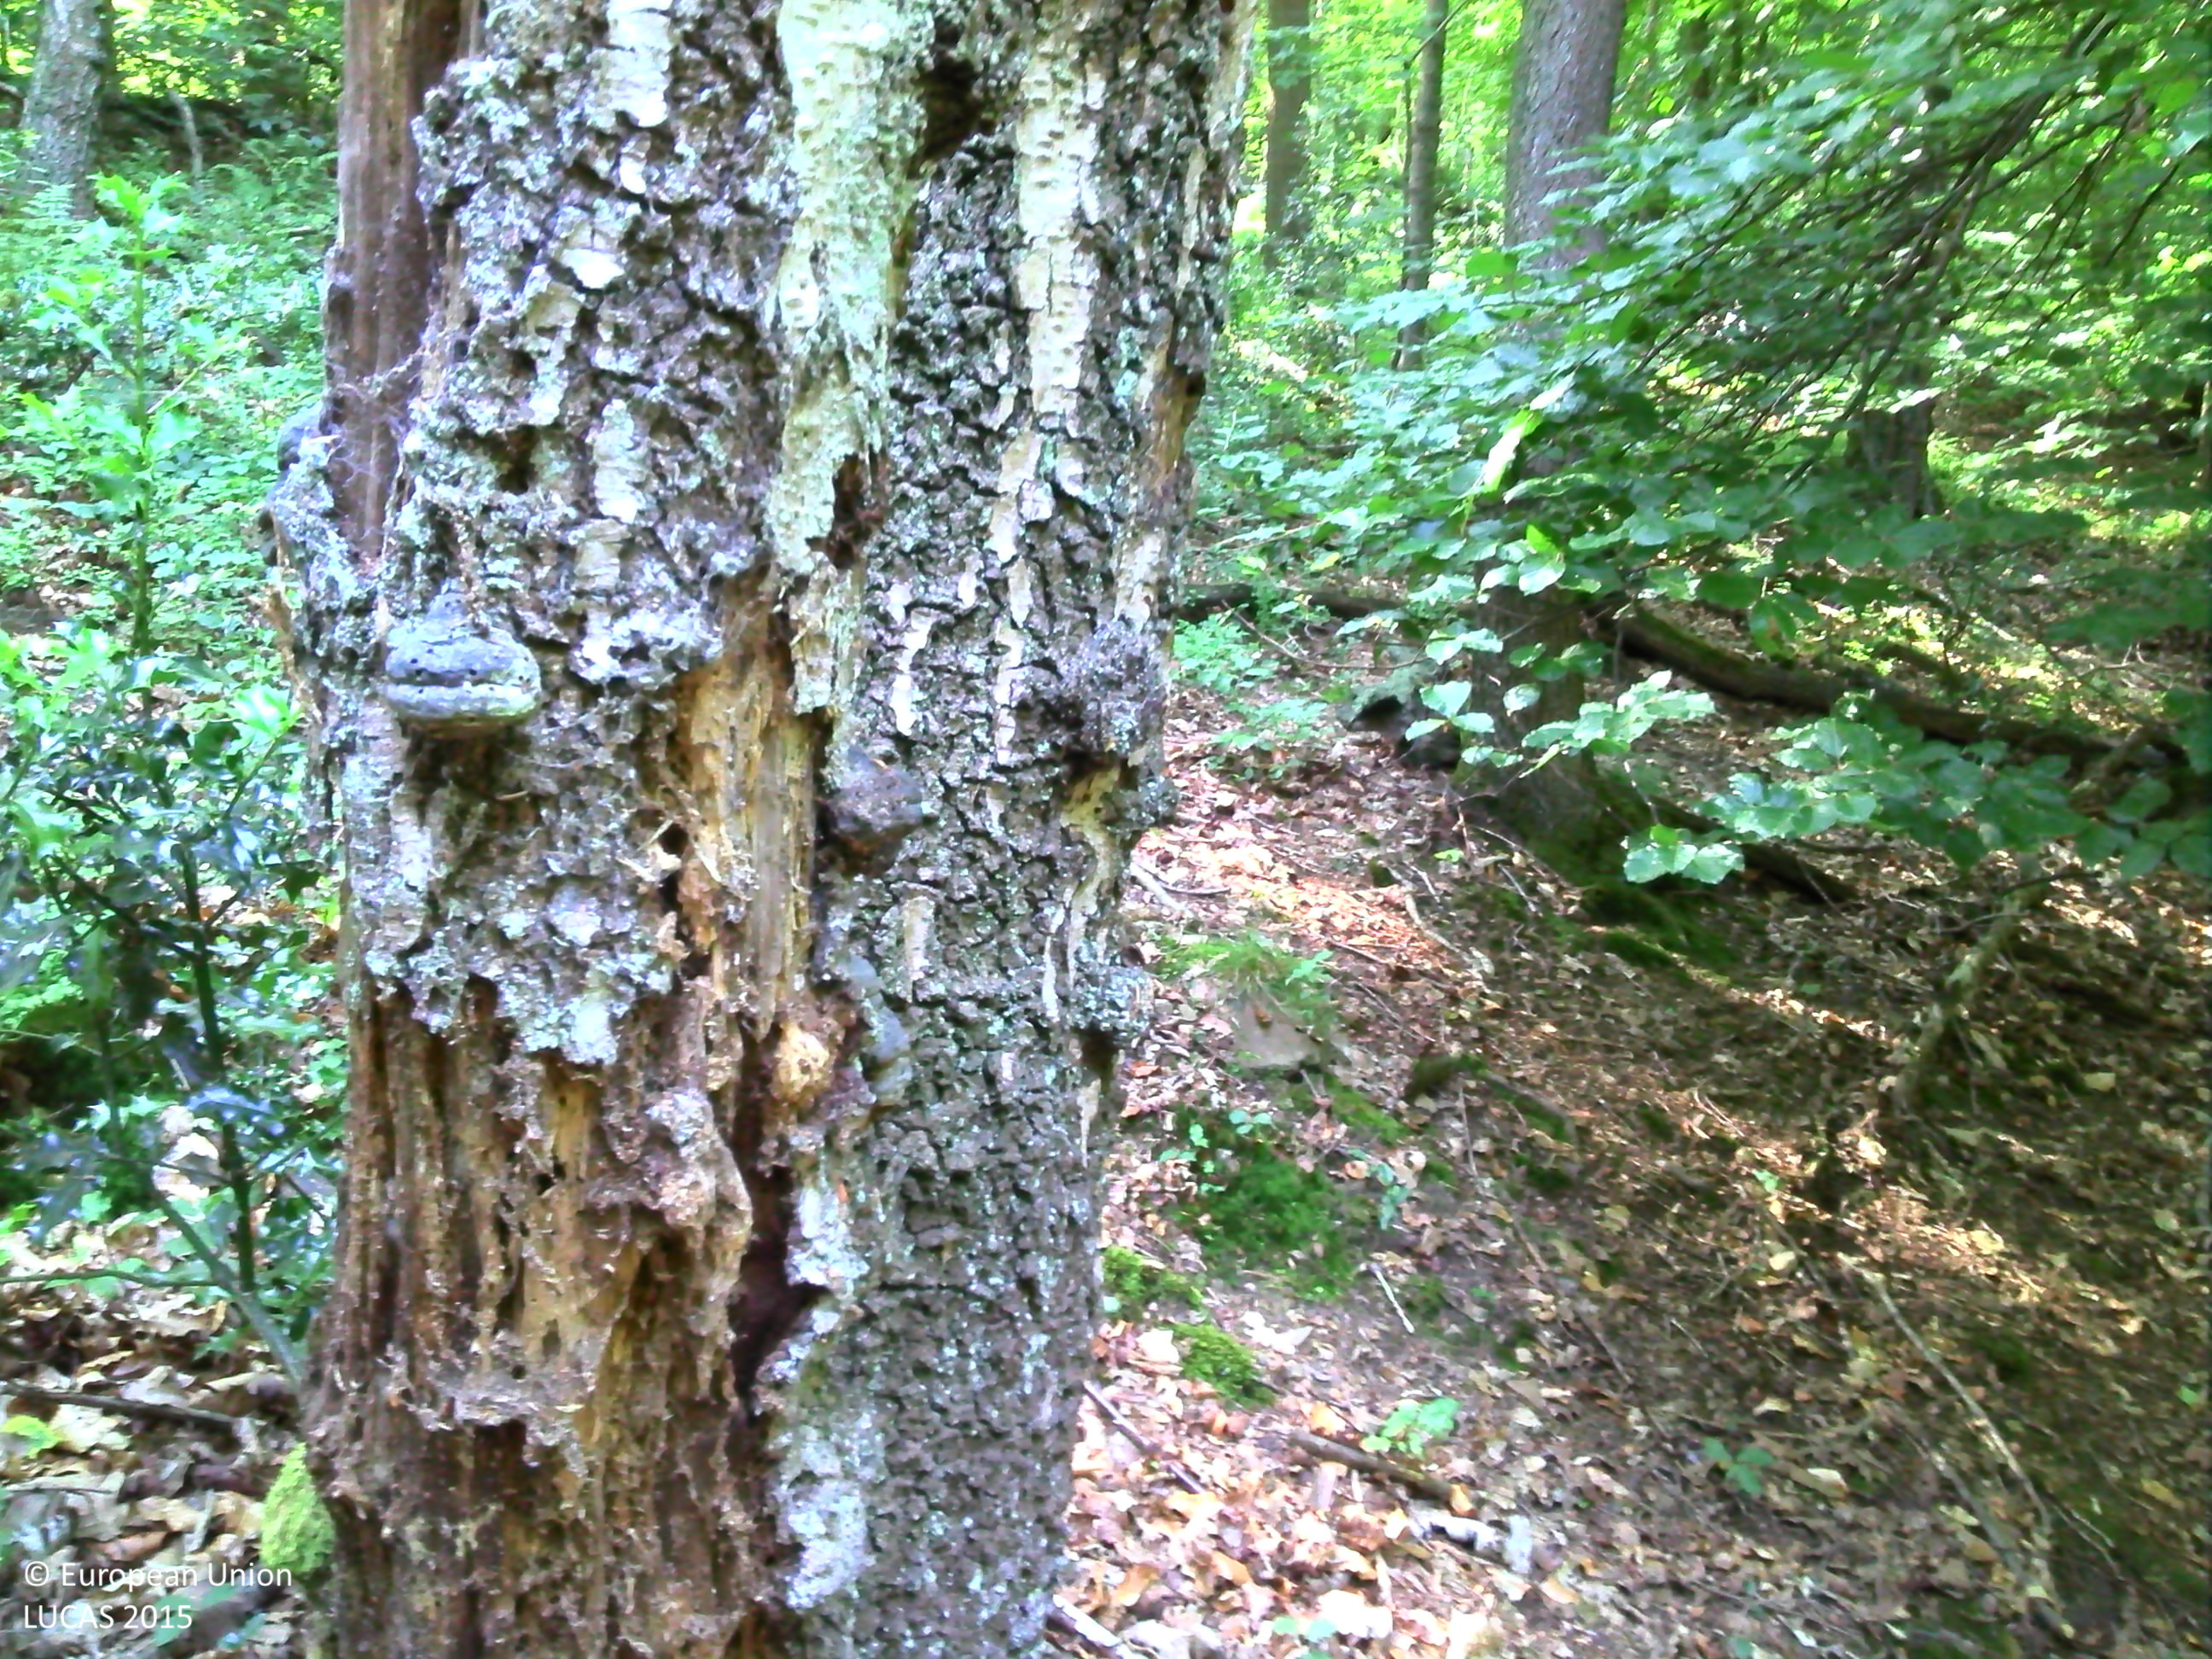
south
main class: Woodland
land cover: Broadleaved woodland
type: acidophilous oak and oak-birch forest
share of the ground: > 75 %
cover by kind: broadleaved forest trees 90 %, herbaceous plants 10 %
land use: Forestry
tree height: > 5 m
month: July
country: BE
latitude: 50.5552
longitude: 5.7501
